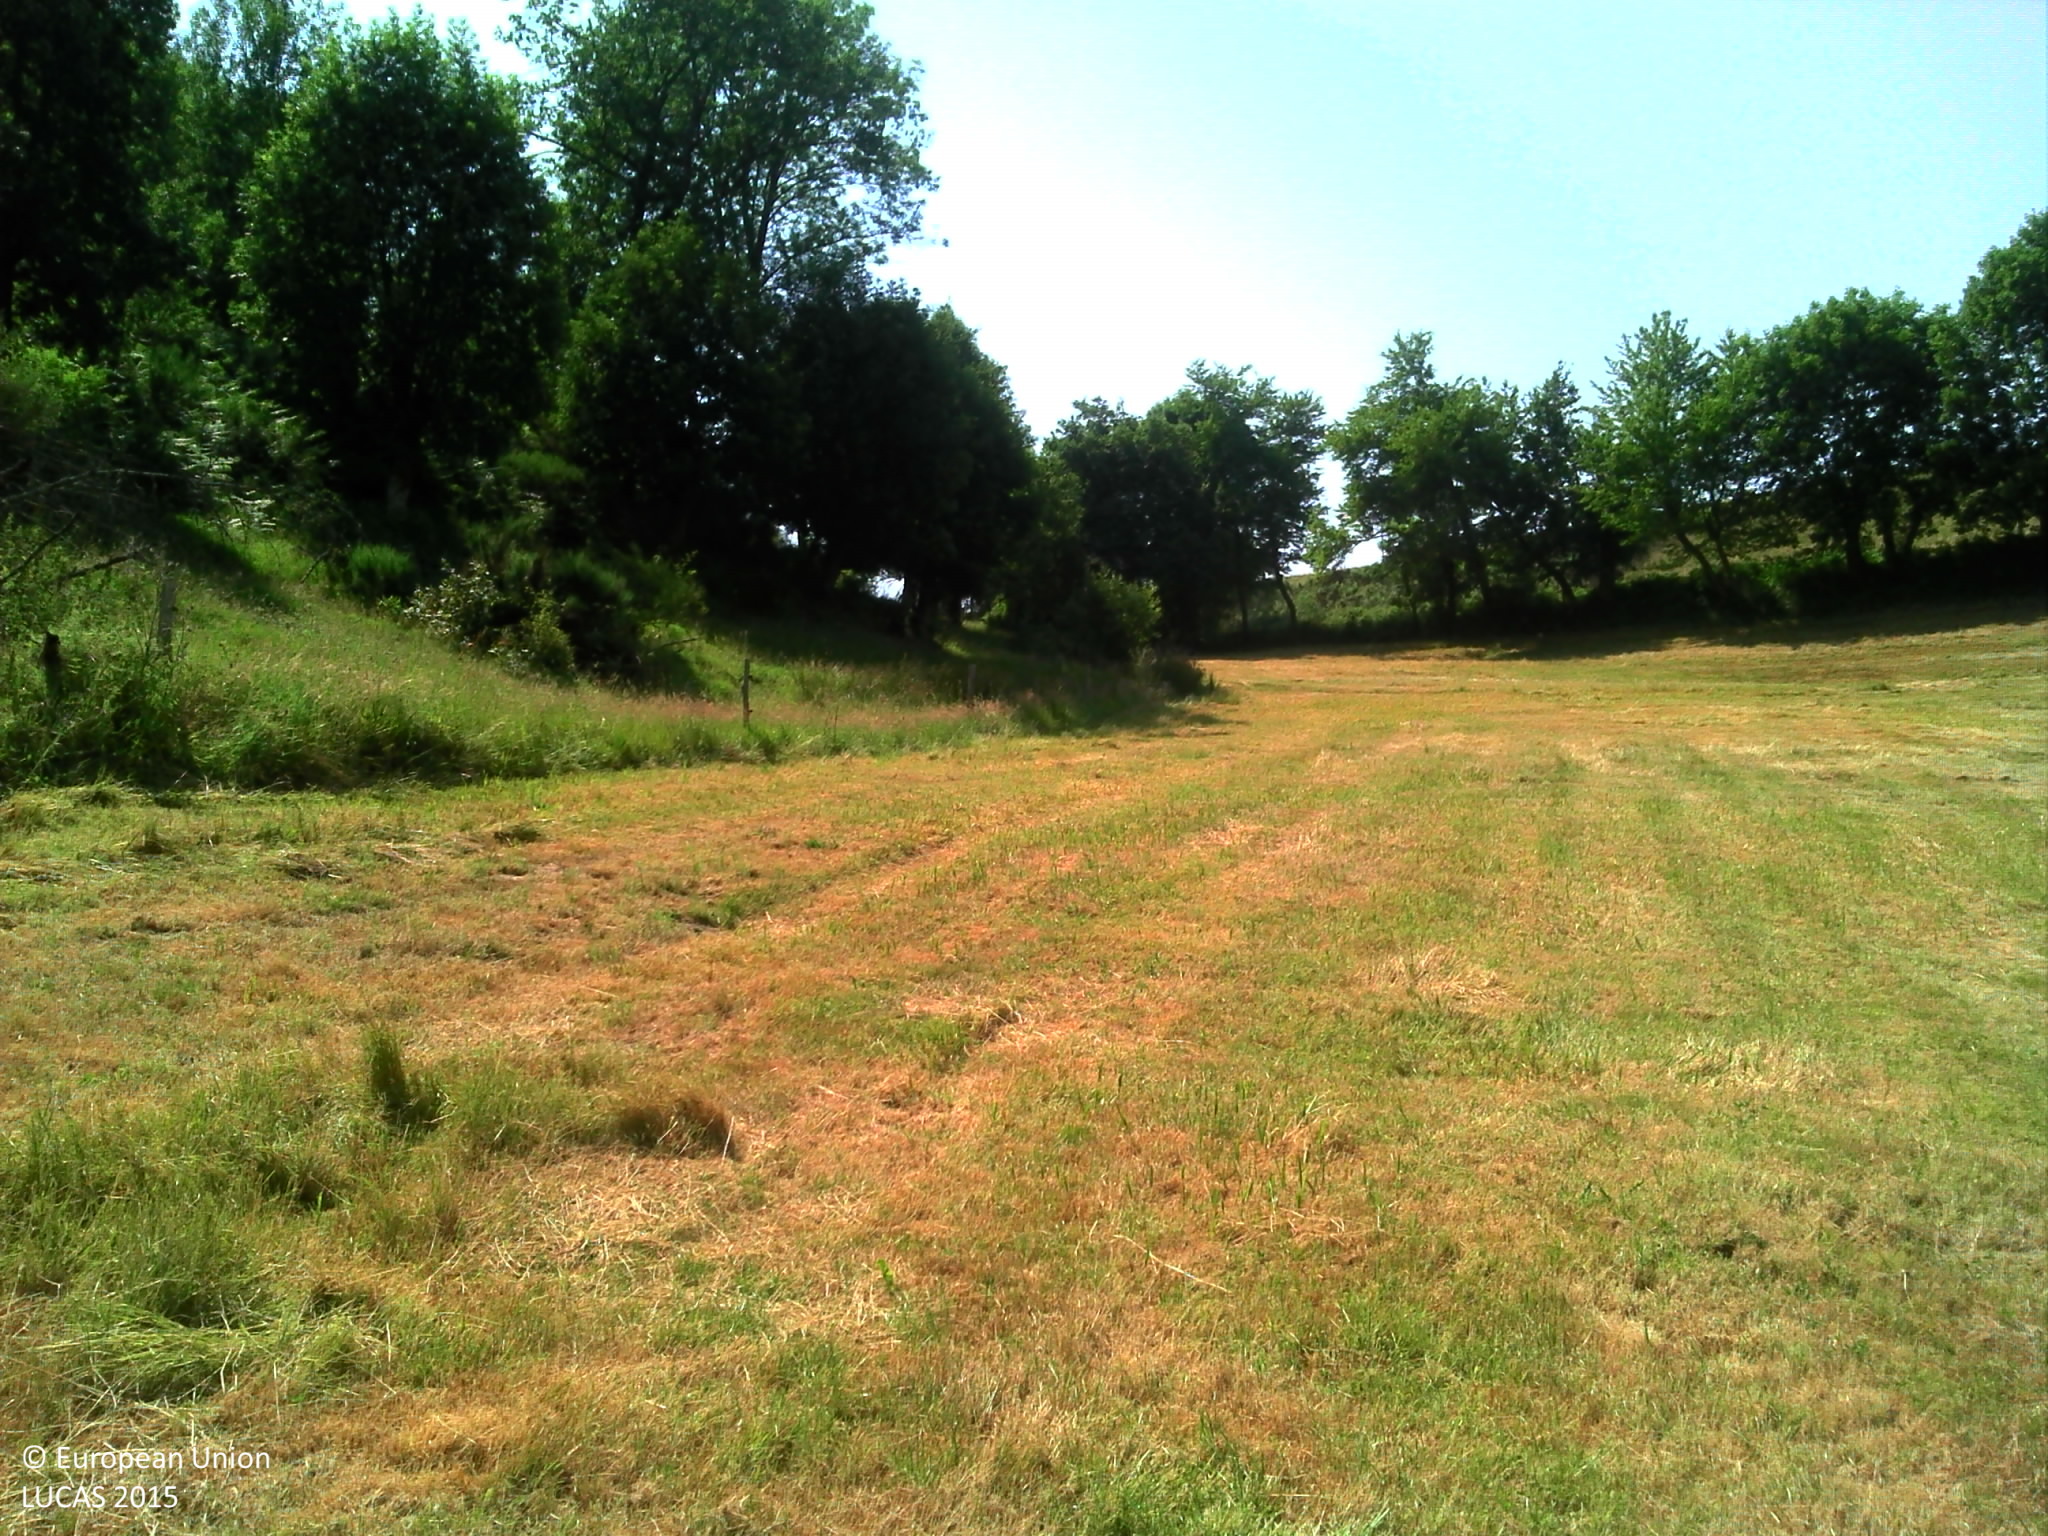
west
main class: Grassland
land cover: Grassland without tree/shrub cover
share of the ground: > 75 %
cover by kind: herbaceous plants 100 %
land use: Agriculture (excluding fallow land and kitchen gardens)
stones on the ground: < 10 %
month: July
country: FR
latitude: 44.8775
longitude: 3.0530
